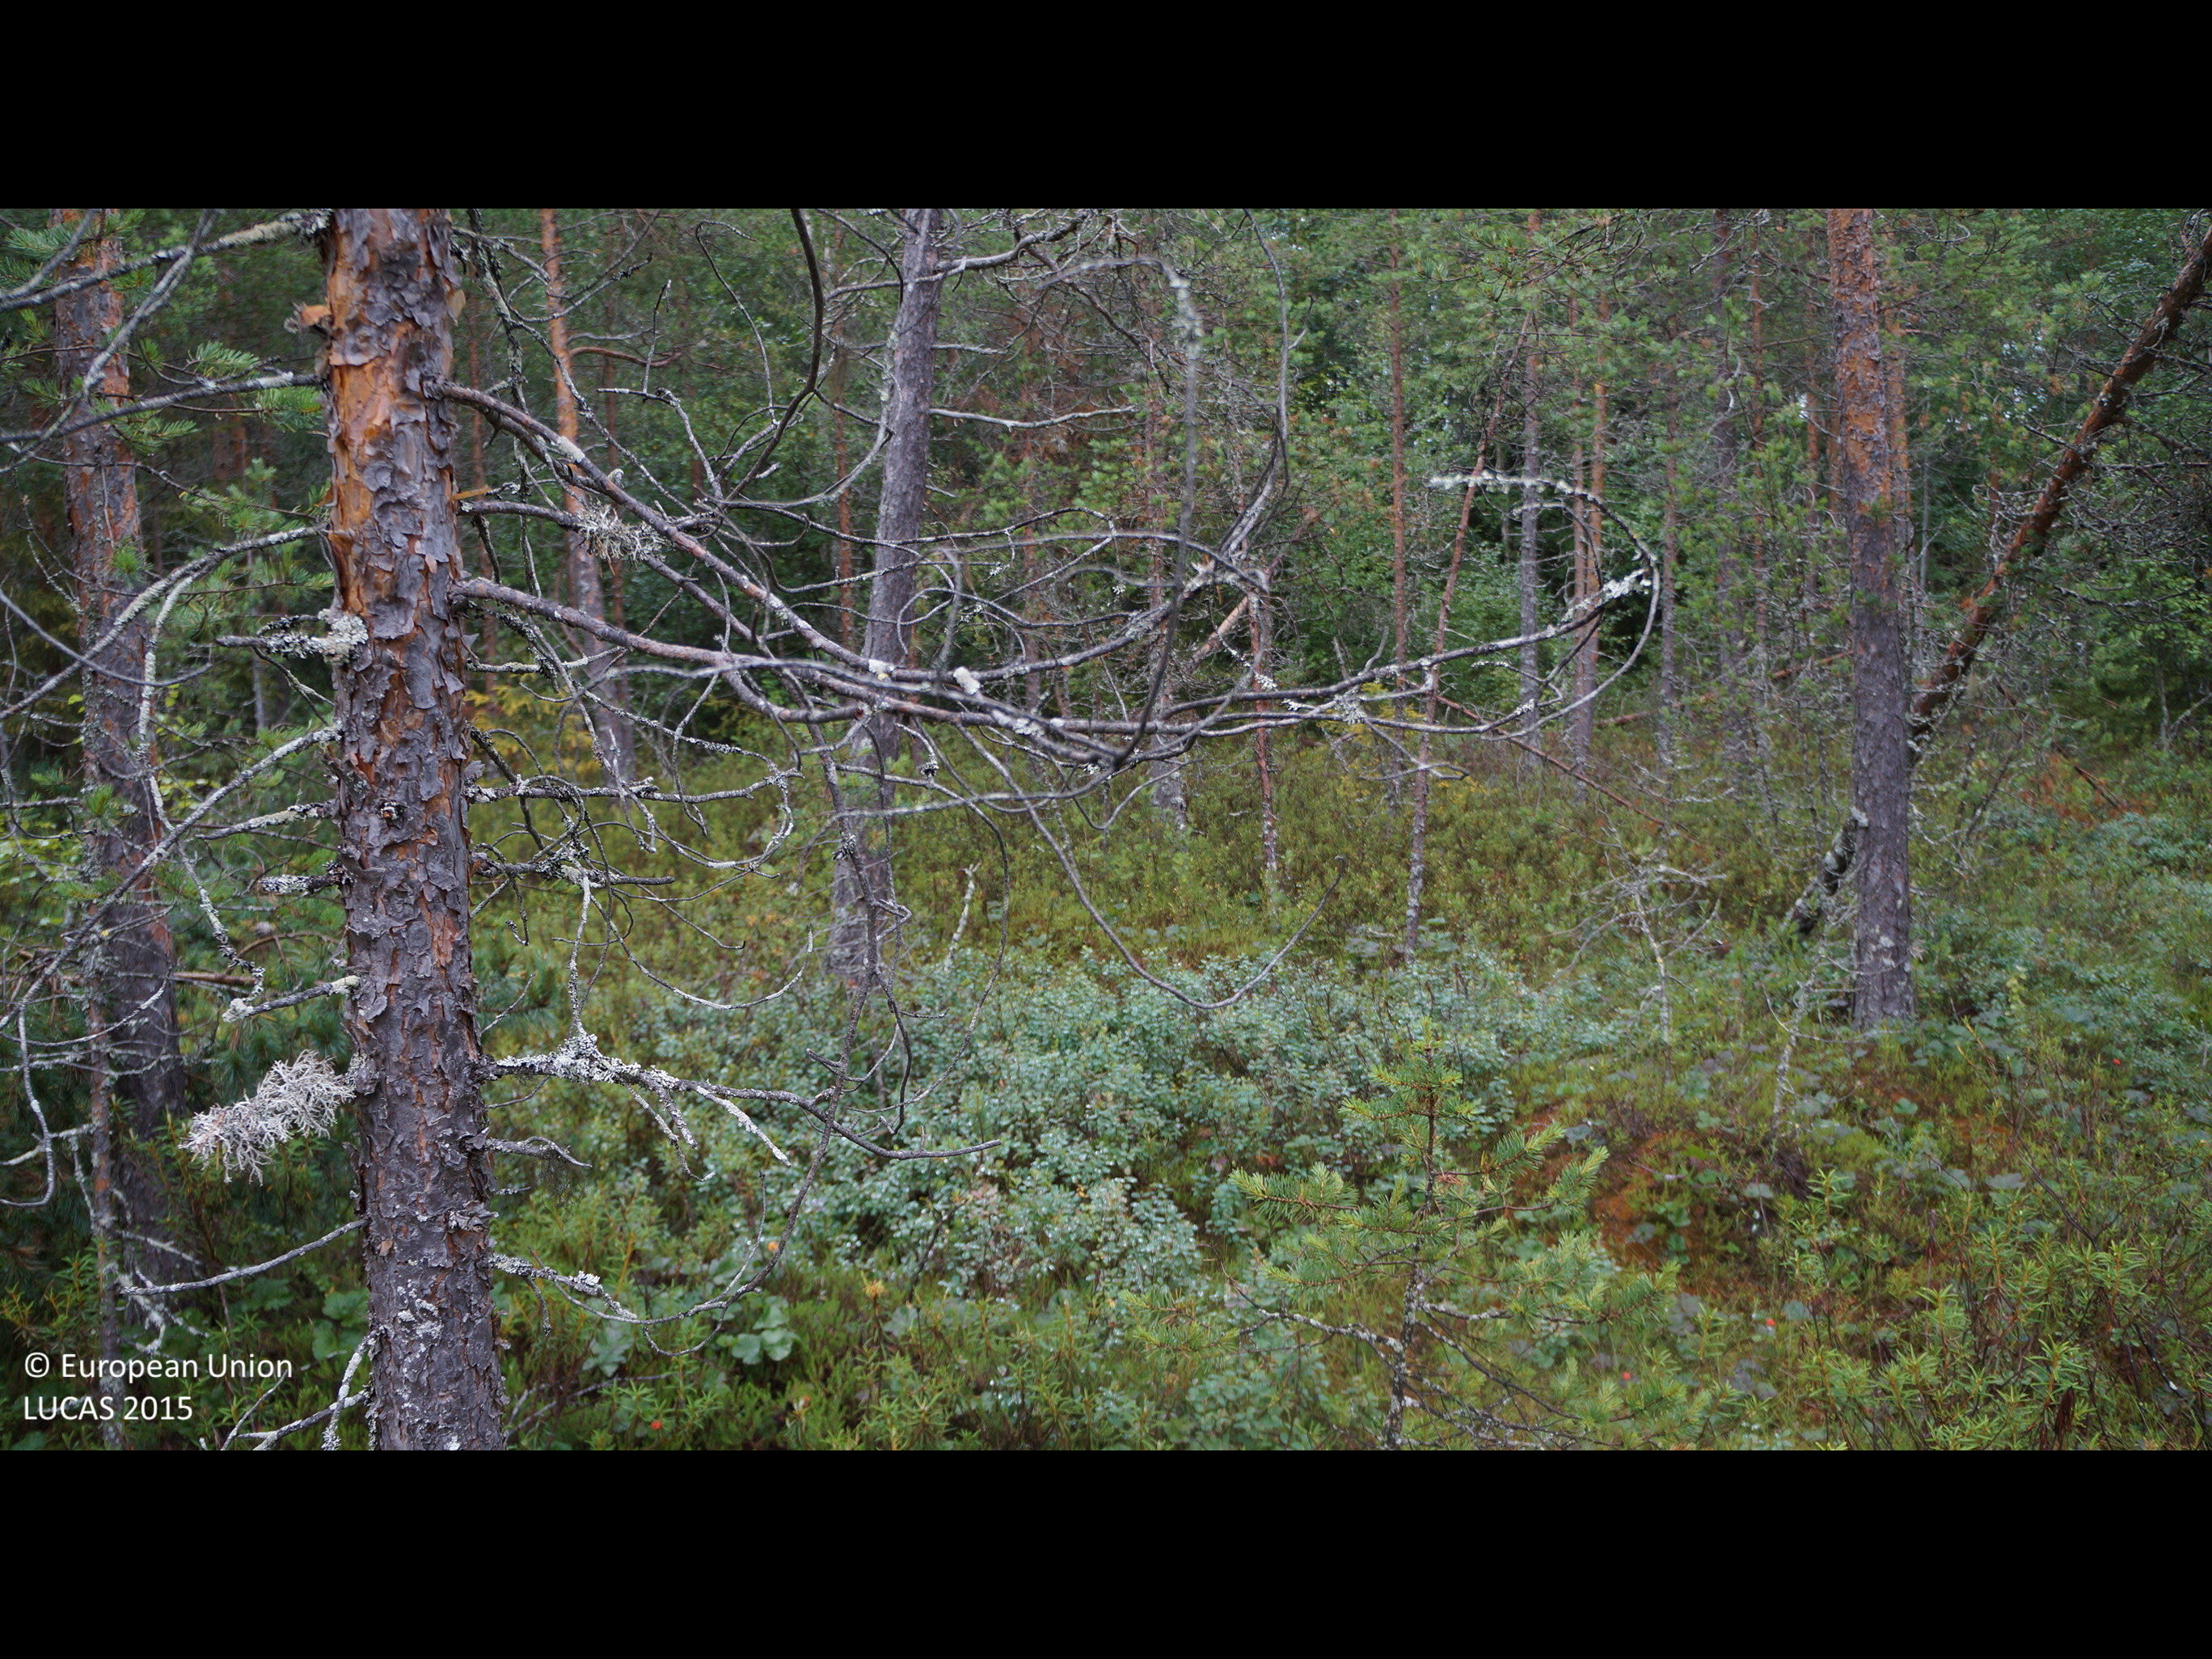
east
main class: Woodland
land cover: Pine dominated coniferous woodland
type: boreal forest
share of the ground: 25 - 50 %
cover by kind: shrubs 50 %, coniferous forest trees 30 %, lichens and mosses 20 %
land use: Forestry
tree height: > 5 m
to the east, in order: Pine dominated coniferous woodland; Ditches and canals; Other mixed woodland; Spruce dominated mixed woodland; Other mixed woodland; Grassland with sparse tree/shrub cover; Grassland without tree/shrub cover
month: July
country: FI
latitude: 63.8037
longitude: 24.4715
